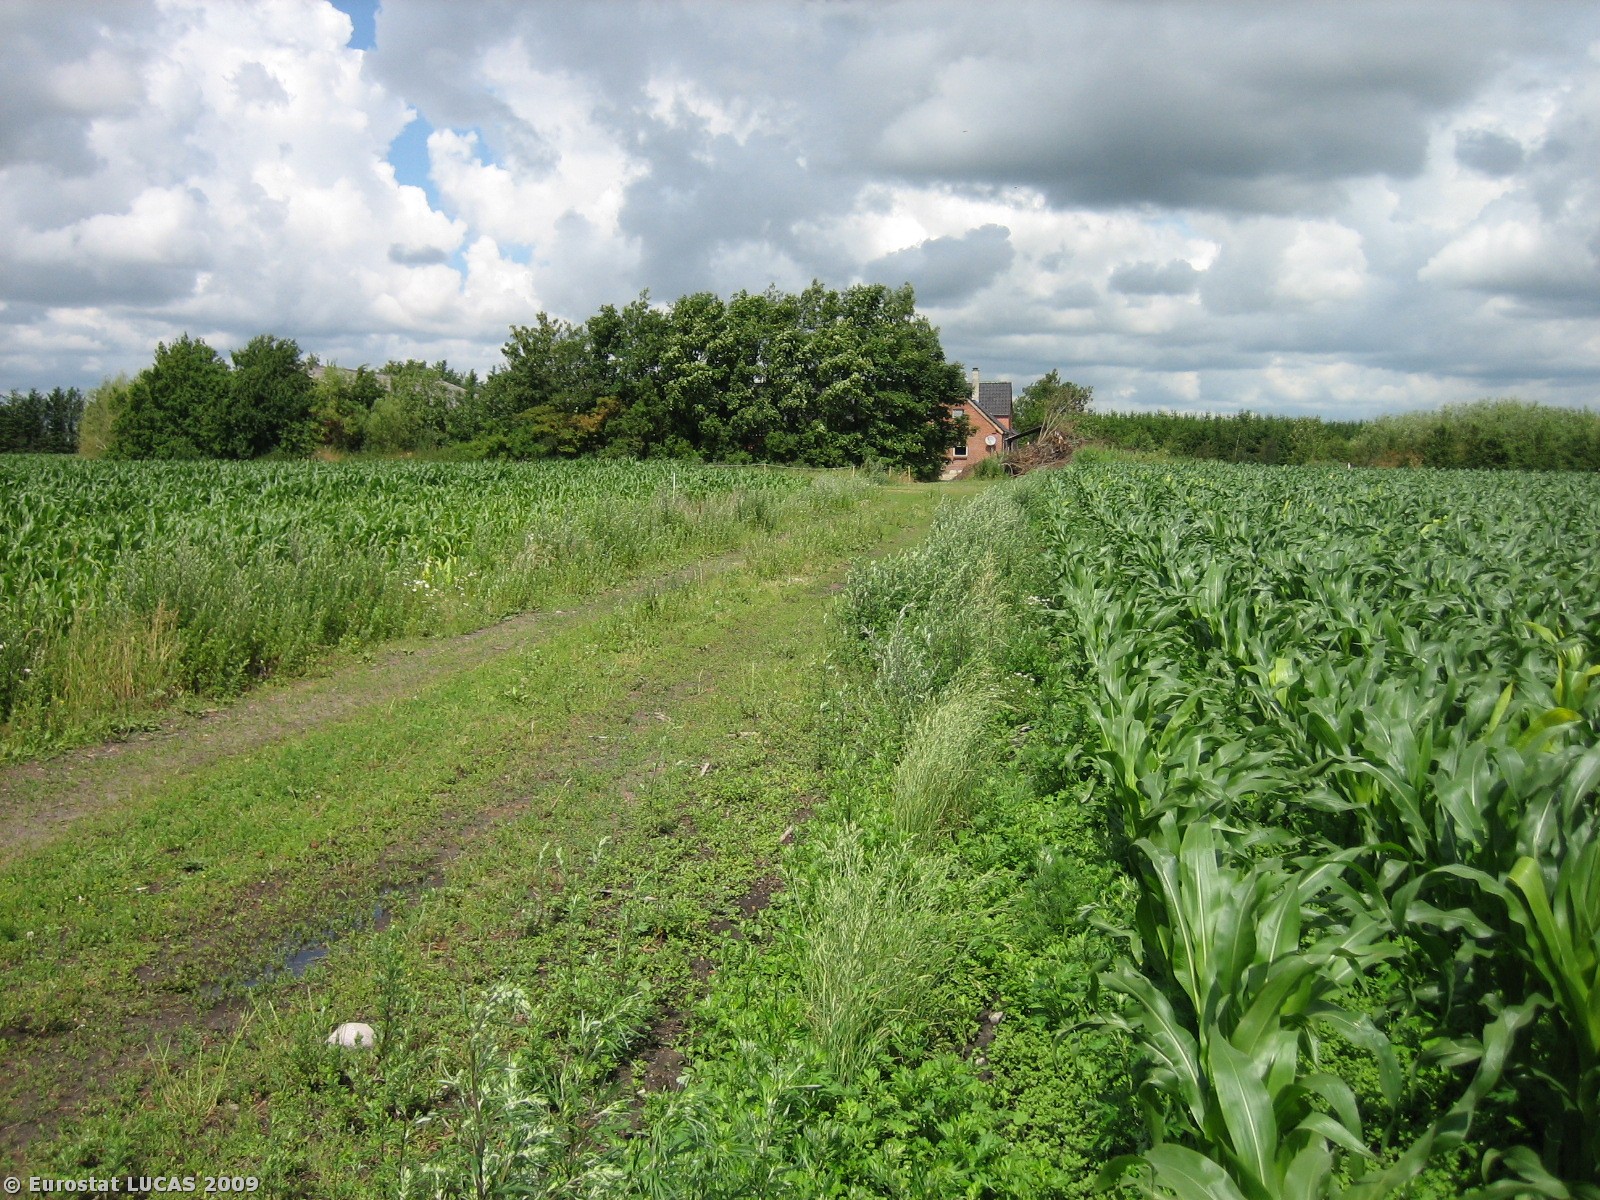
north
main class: Cropland
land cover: Maize
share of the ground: 25 - 50 %
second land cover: Spontaneously vegetated surfaces
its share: > 75 %
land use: Agriculture (excluding fallow land and kitchen gardens)
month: July
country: DK
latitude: 55.6426
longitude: 8.7778
